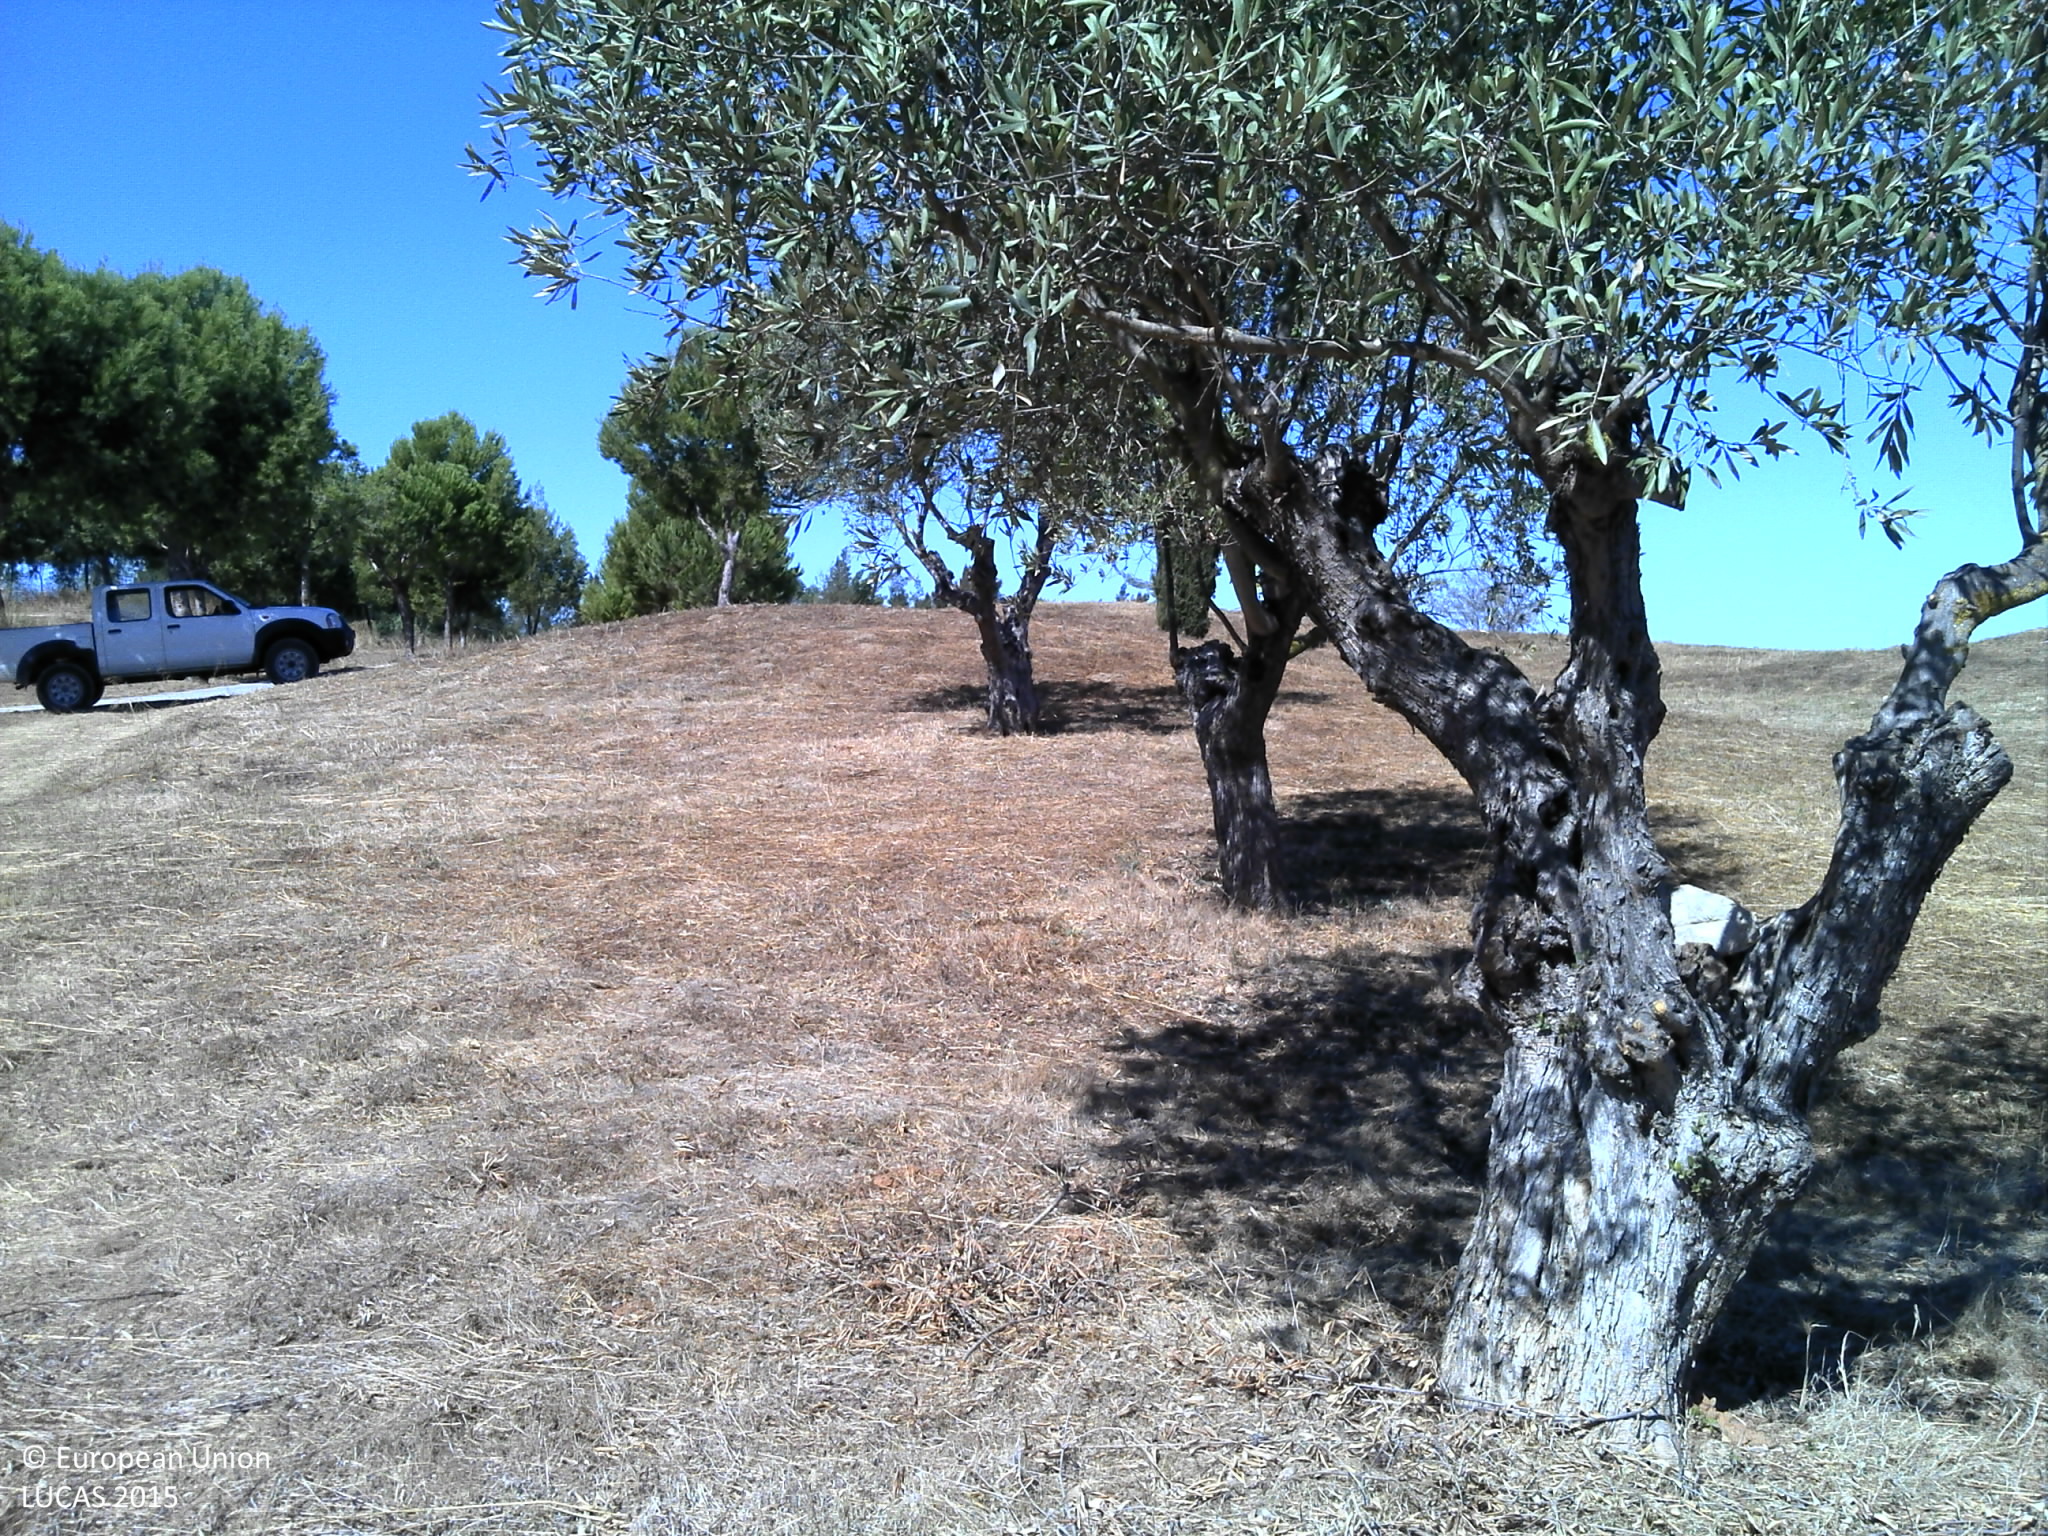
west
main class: Cropland
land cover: Olive groves
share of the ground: 25 - 50 %
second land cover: Grassland without tree/shrub cover
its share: 50 - 75 %
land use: Amenities, museums, leisure
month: September
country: PT
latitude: 37.0982
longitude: -8.1413
